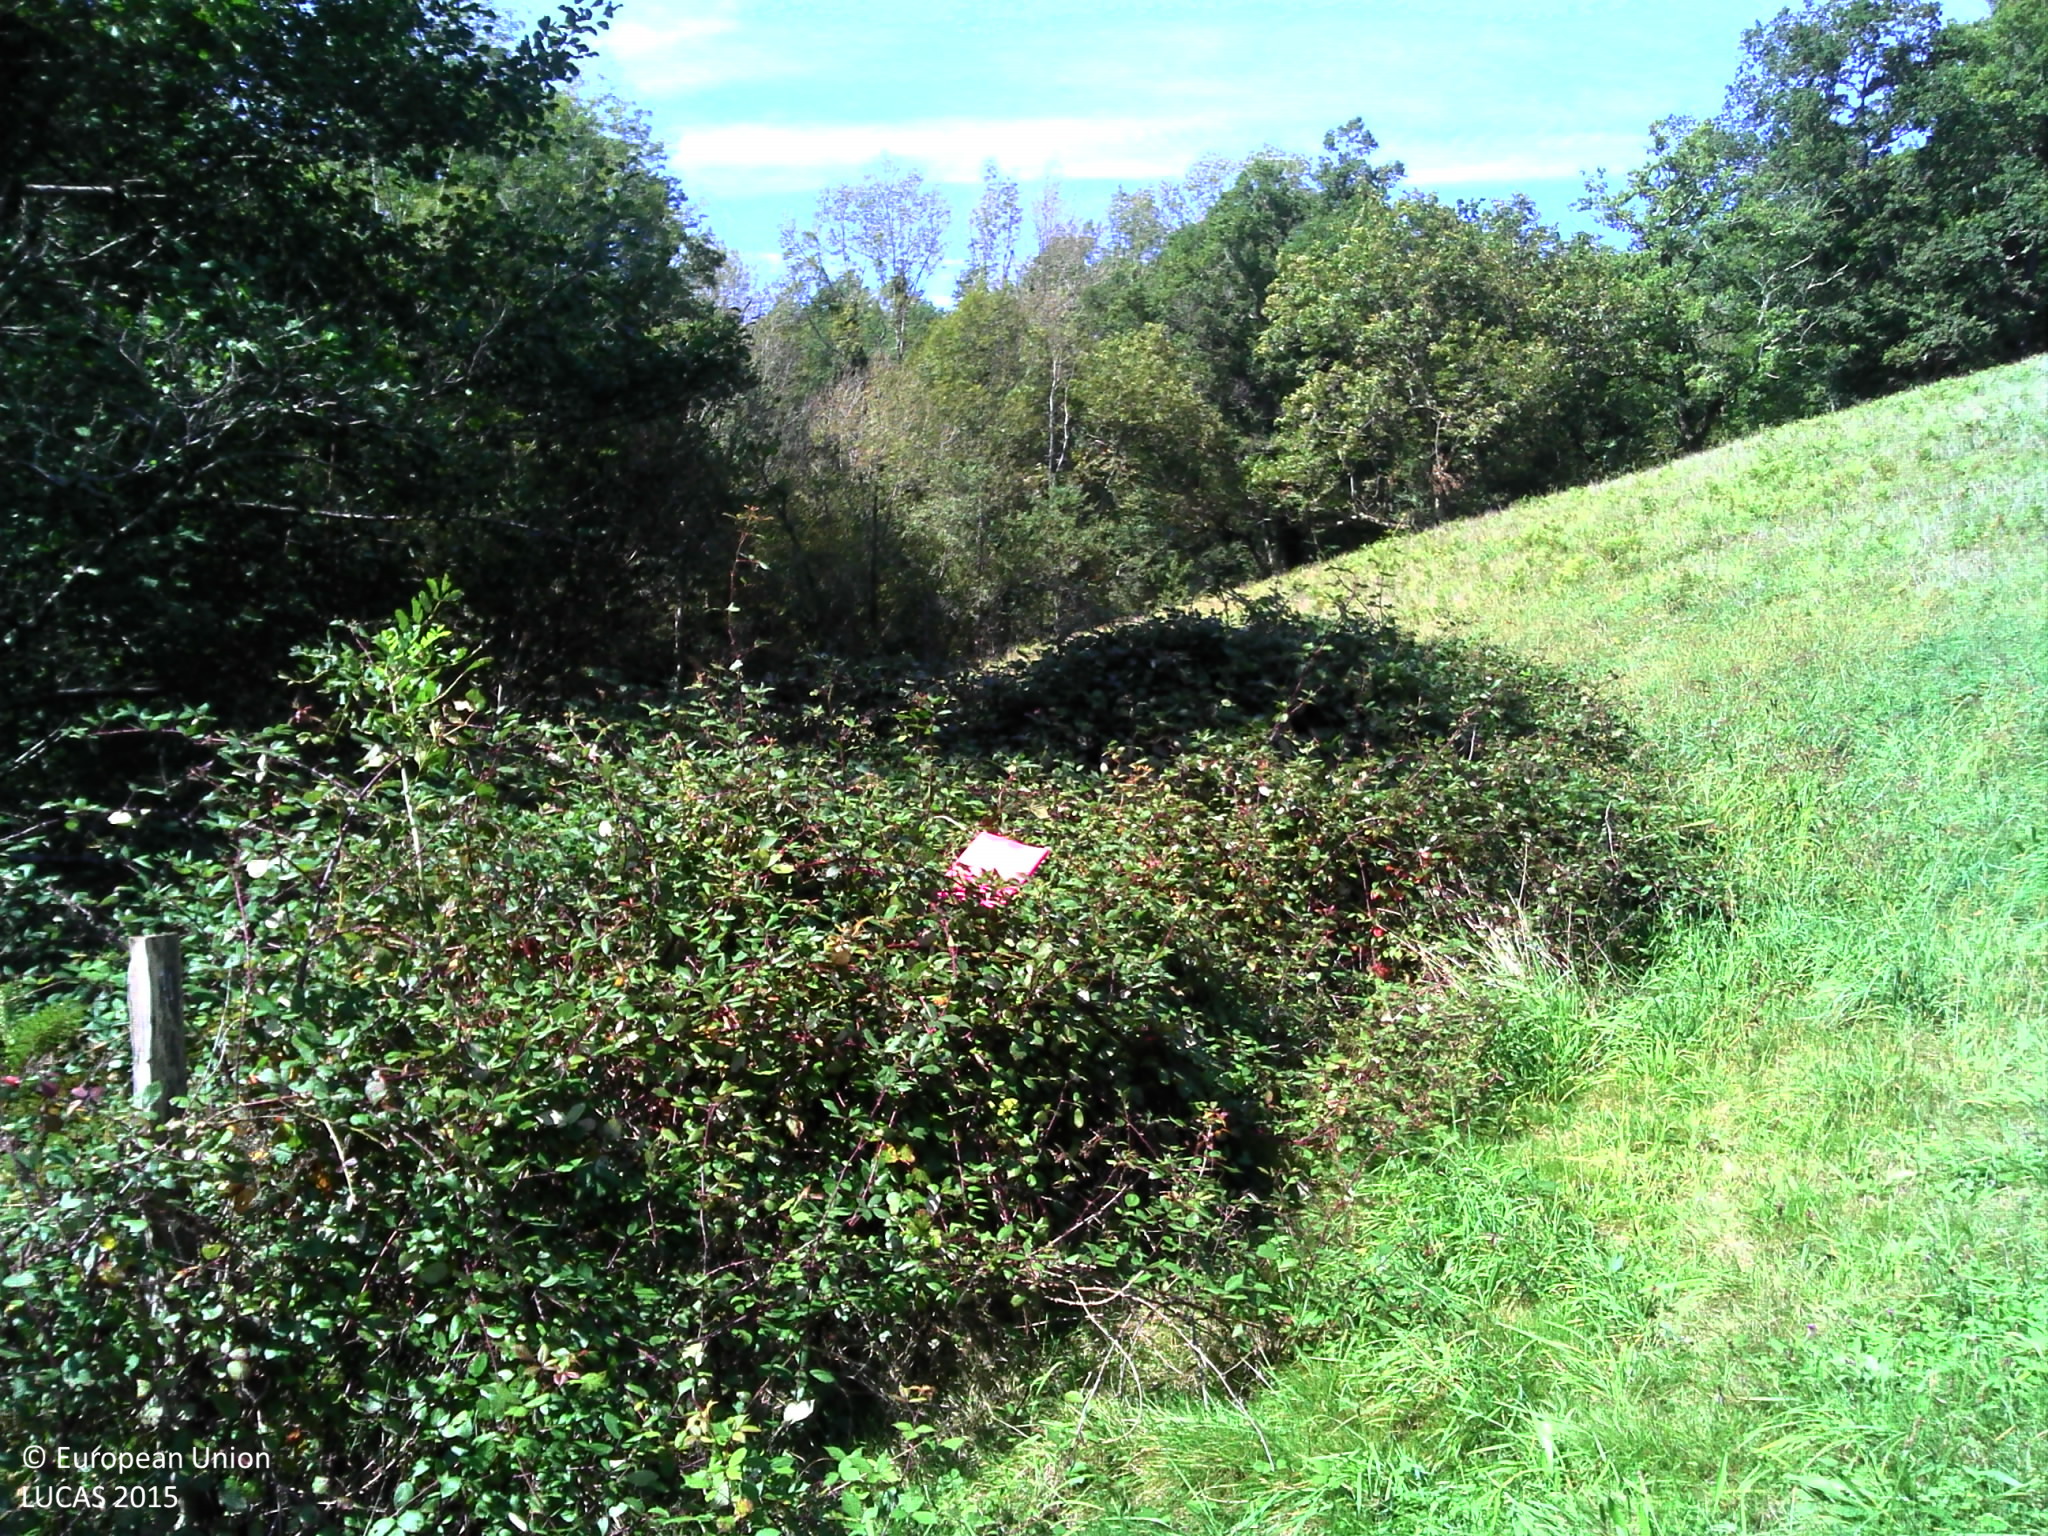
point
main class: Grassland
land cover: Grassland without tree/shrub cover
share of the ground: > 75 %
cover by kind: herbaceous plants 95 %, shrubs 5 %
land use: Agriculture (excluding fallow land and kitchen gardens)
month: September
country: FR
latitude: 43.0934
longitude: -0.6342
